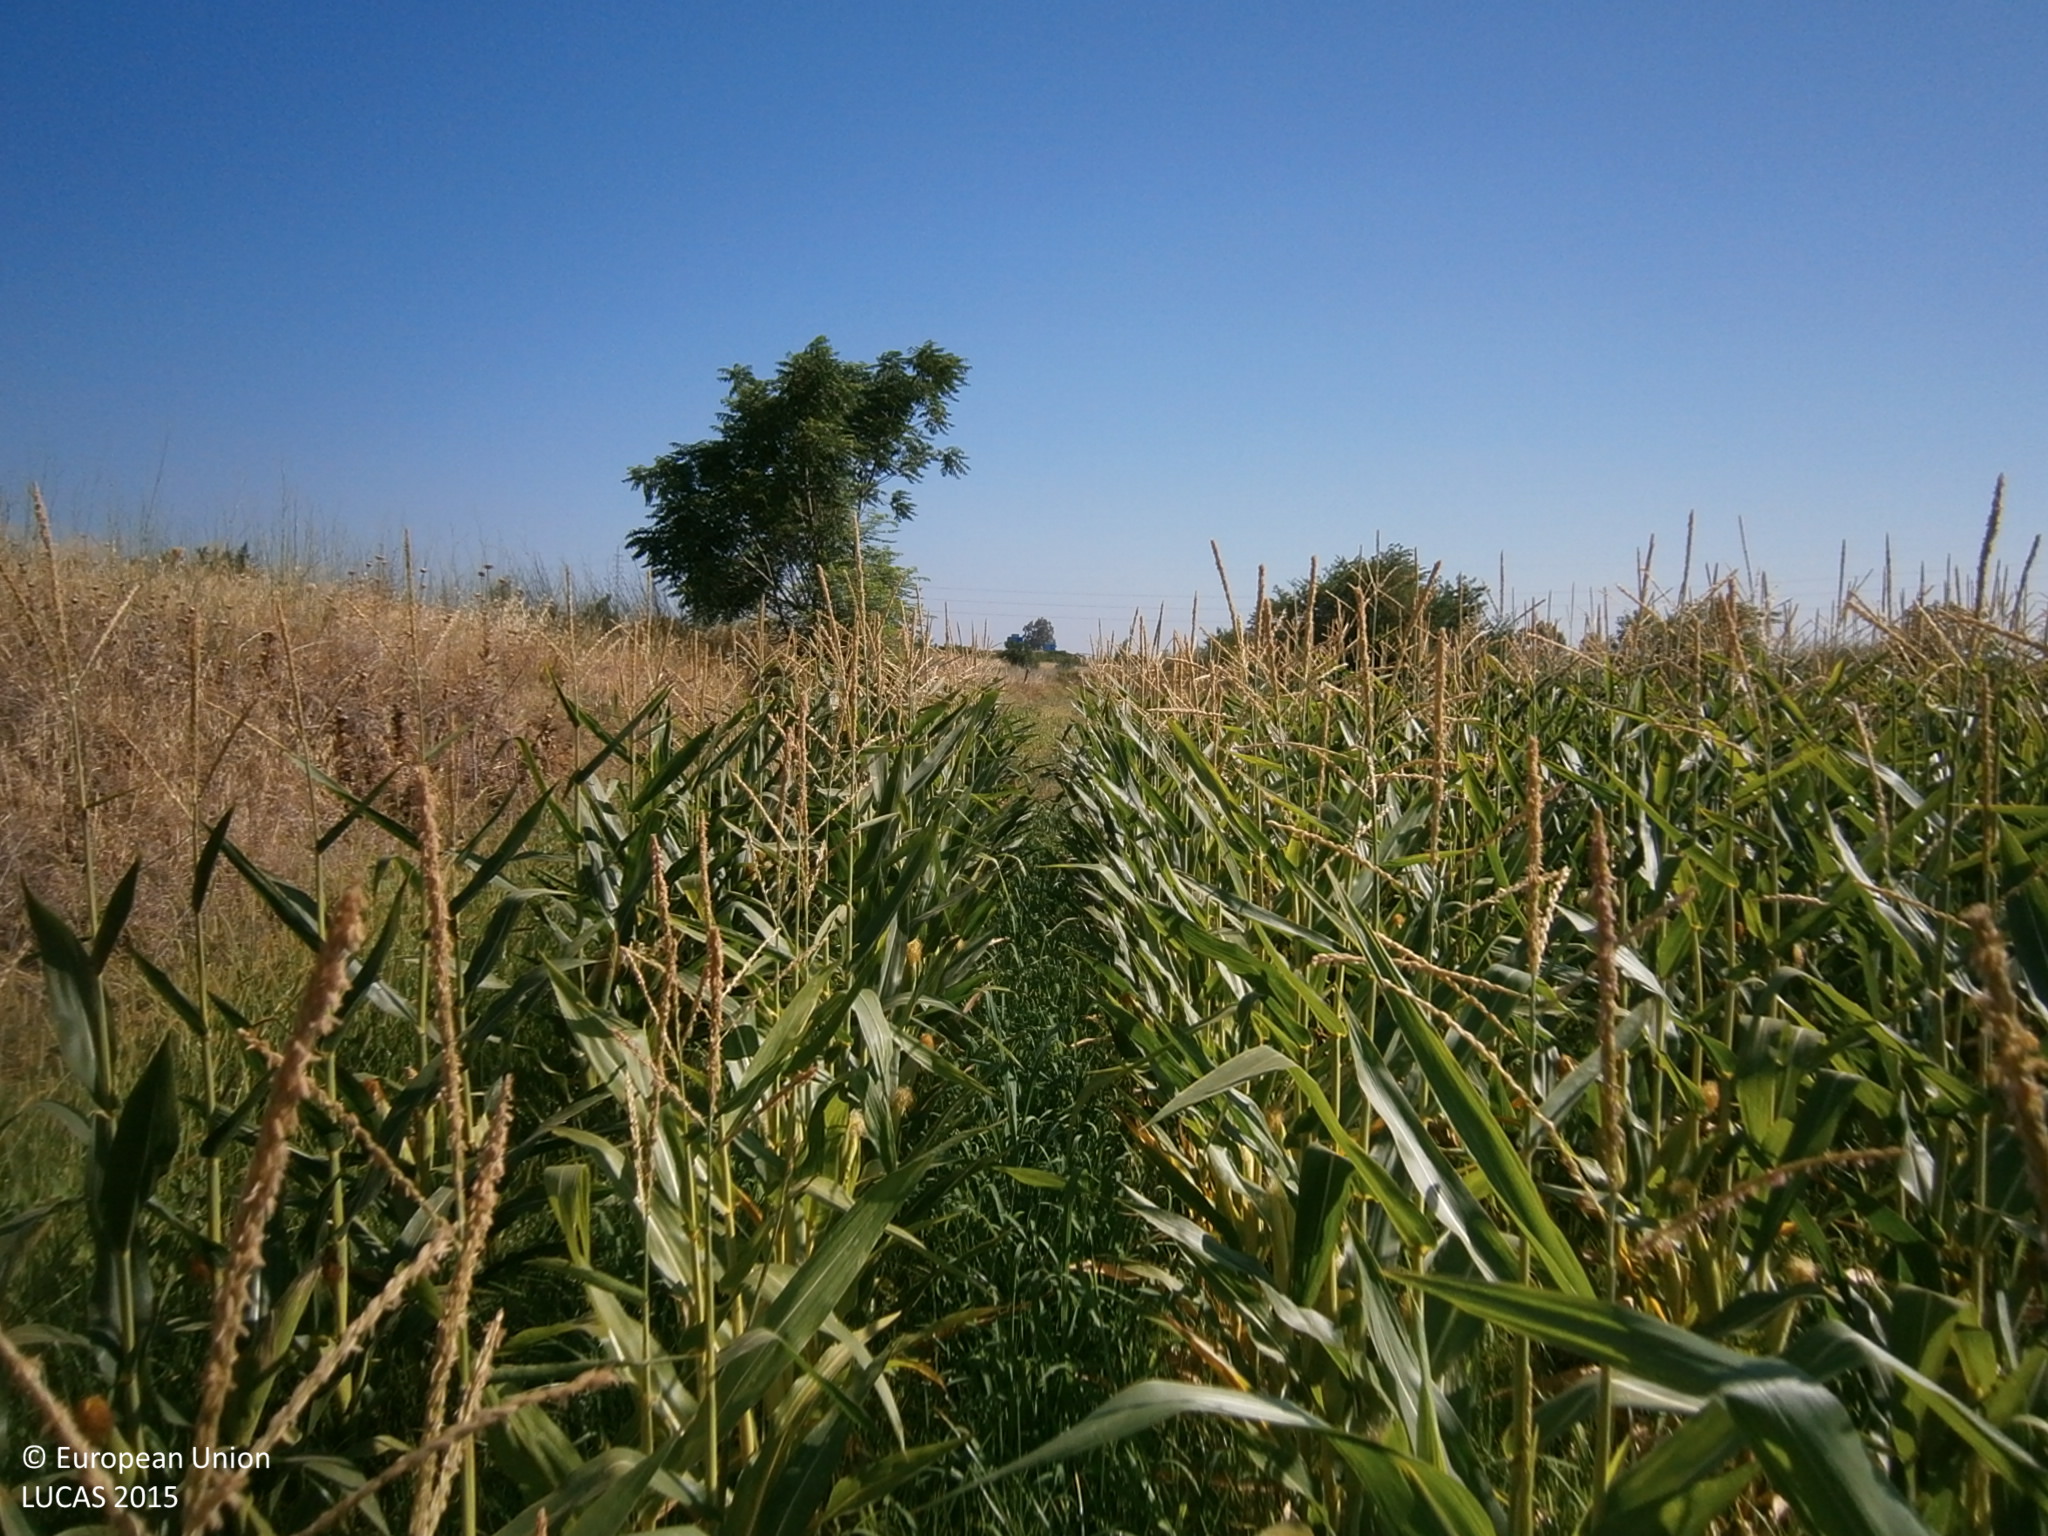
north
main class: Cropland
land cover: Maize
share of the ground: > 75 %
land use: Agriculture (excluding fallow land and kitchen gardens)
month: July
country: ES
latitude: 38.9069
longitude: -6.9640
